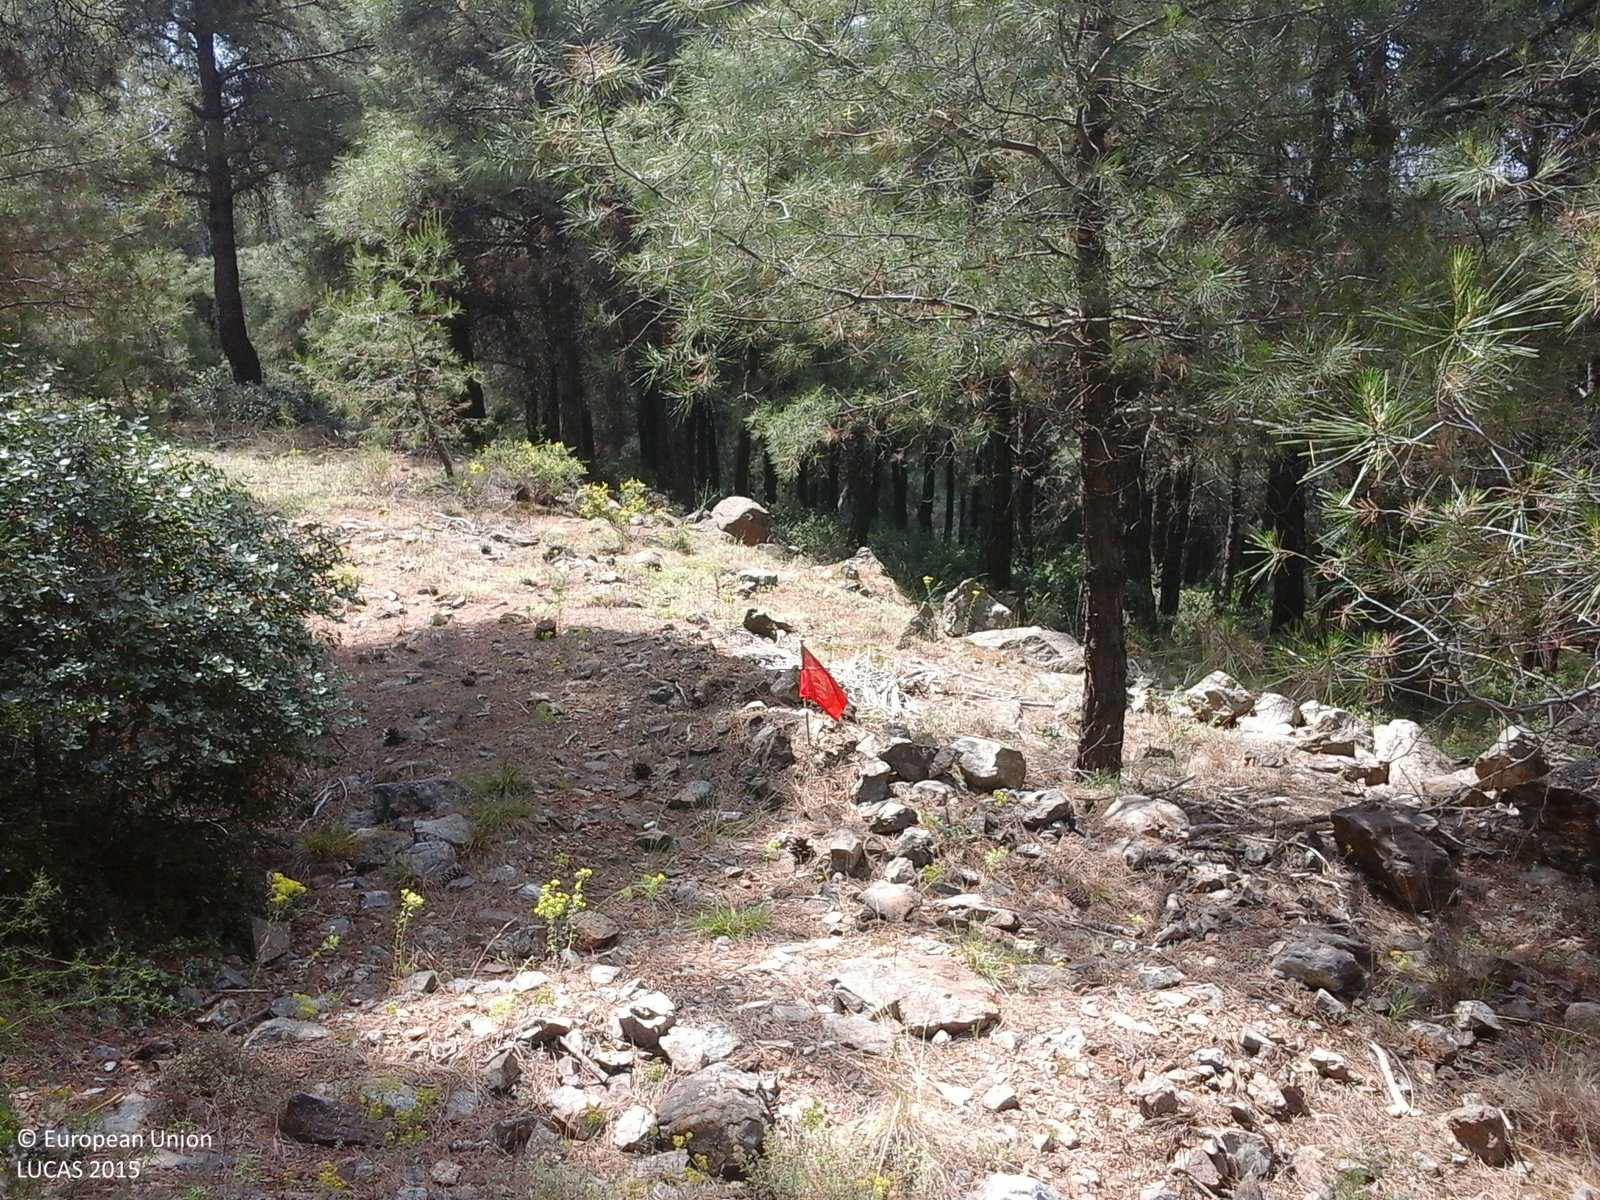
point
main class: Woodland
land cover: Pine dominated coniferous woodland
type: coniferous forest of the mediterranean region
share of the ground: > 75 %
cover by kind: coniferous forest trees 75 %, herbaceous plants 10 %, consolidated bare surface 10 %, shrubs 5 %
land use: Amenities, museums, leisure
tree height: > 5 m
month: June
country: GR
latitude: 40.6451
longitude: 22.9800
